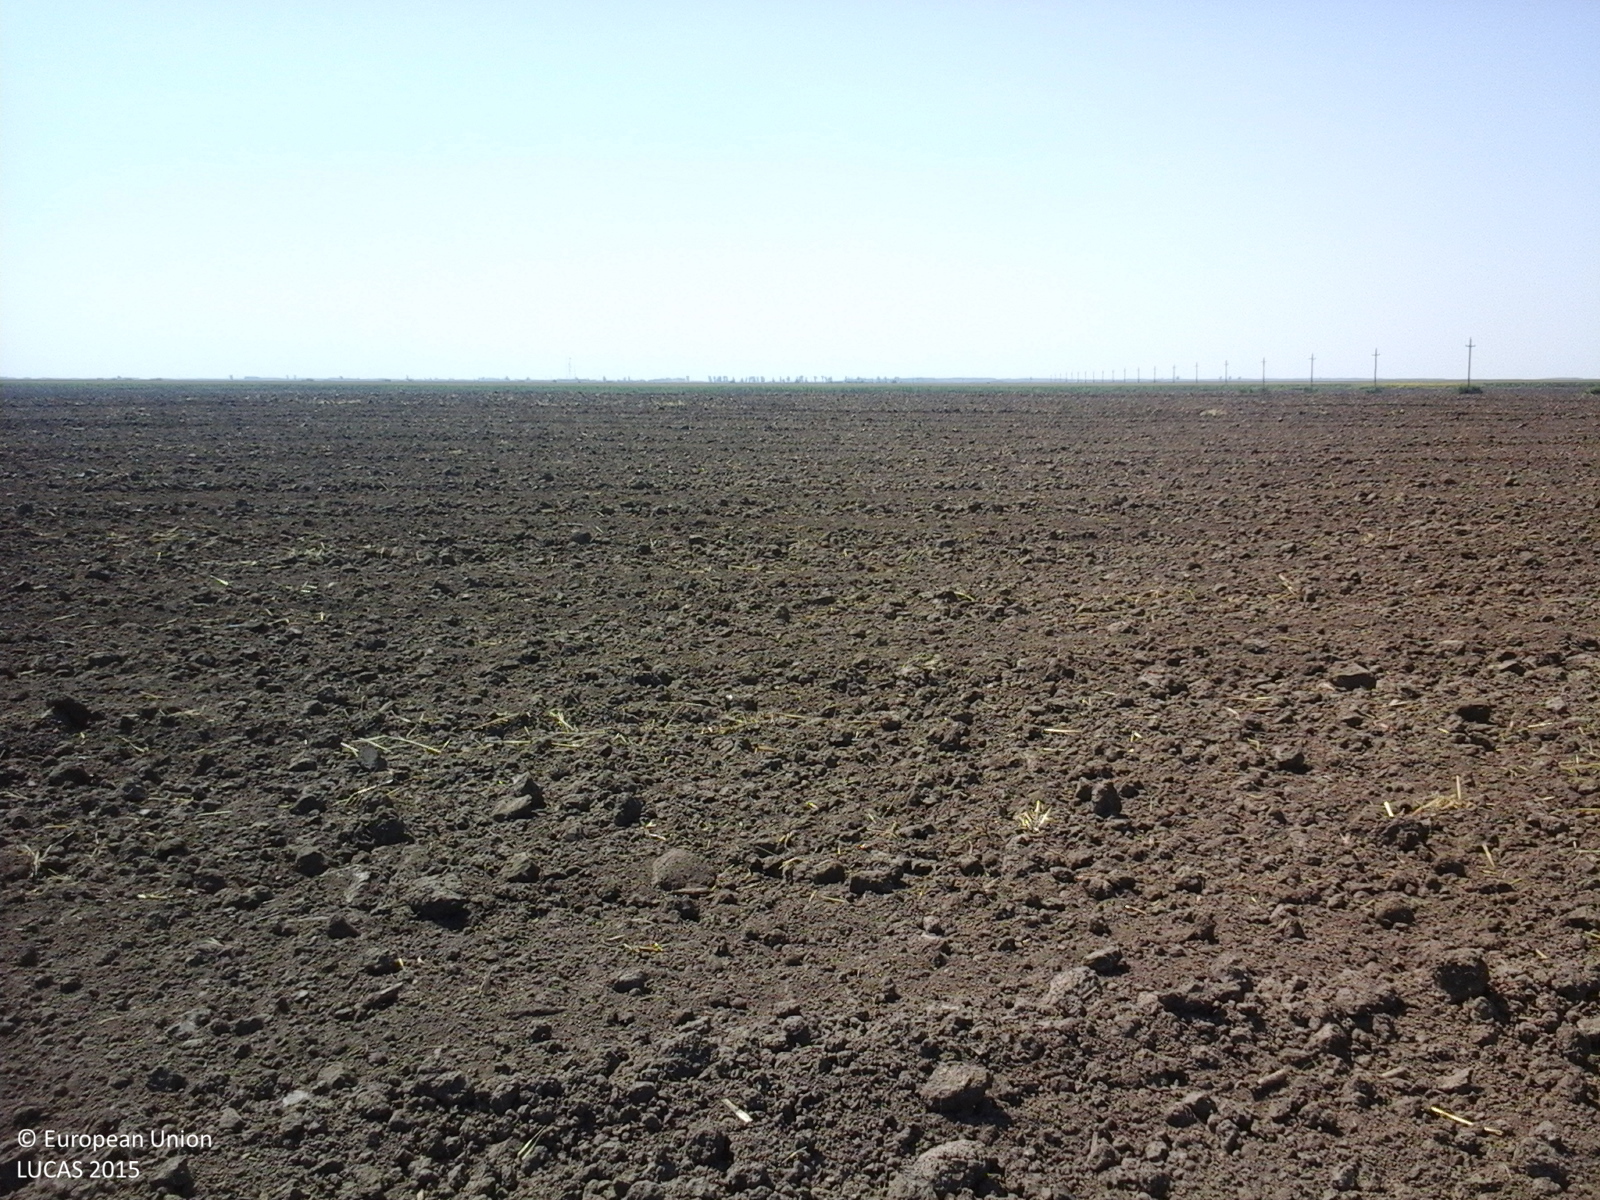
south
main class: Cropland
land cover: Durum wheat
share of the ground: < 10 %
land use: Agriculture (excluding fallow land and kitchen gardens)
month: July
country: RO
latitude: 44.4972
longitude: 27.1229
